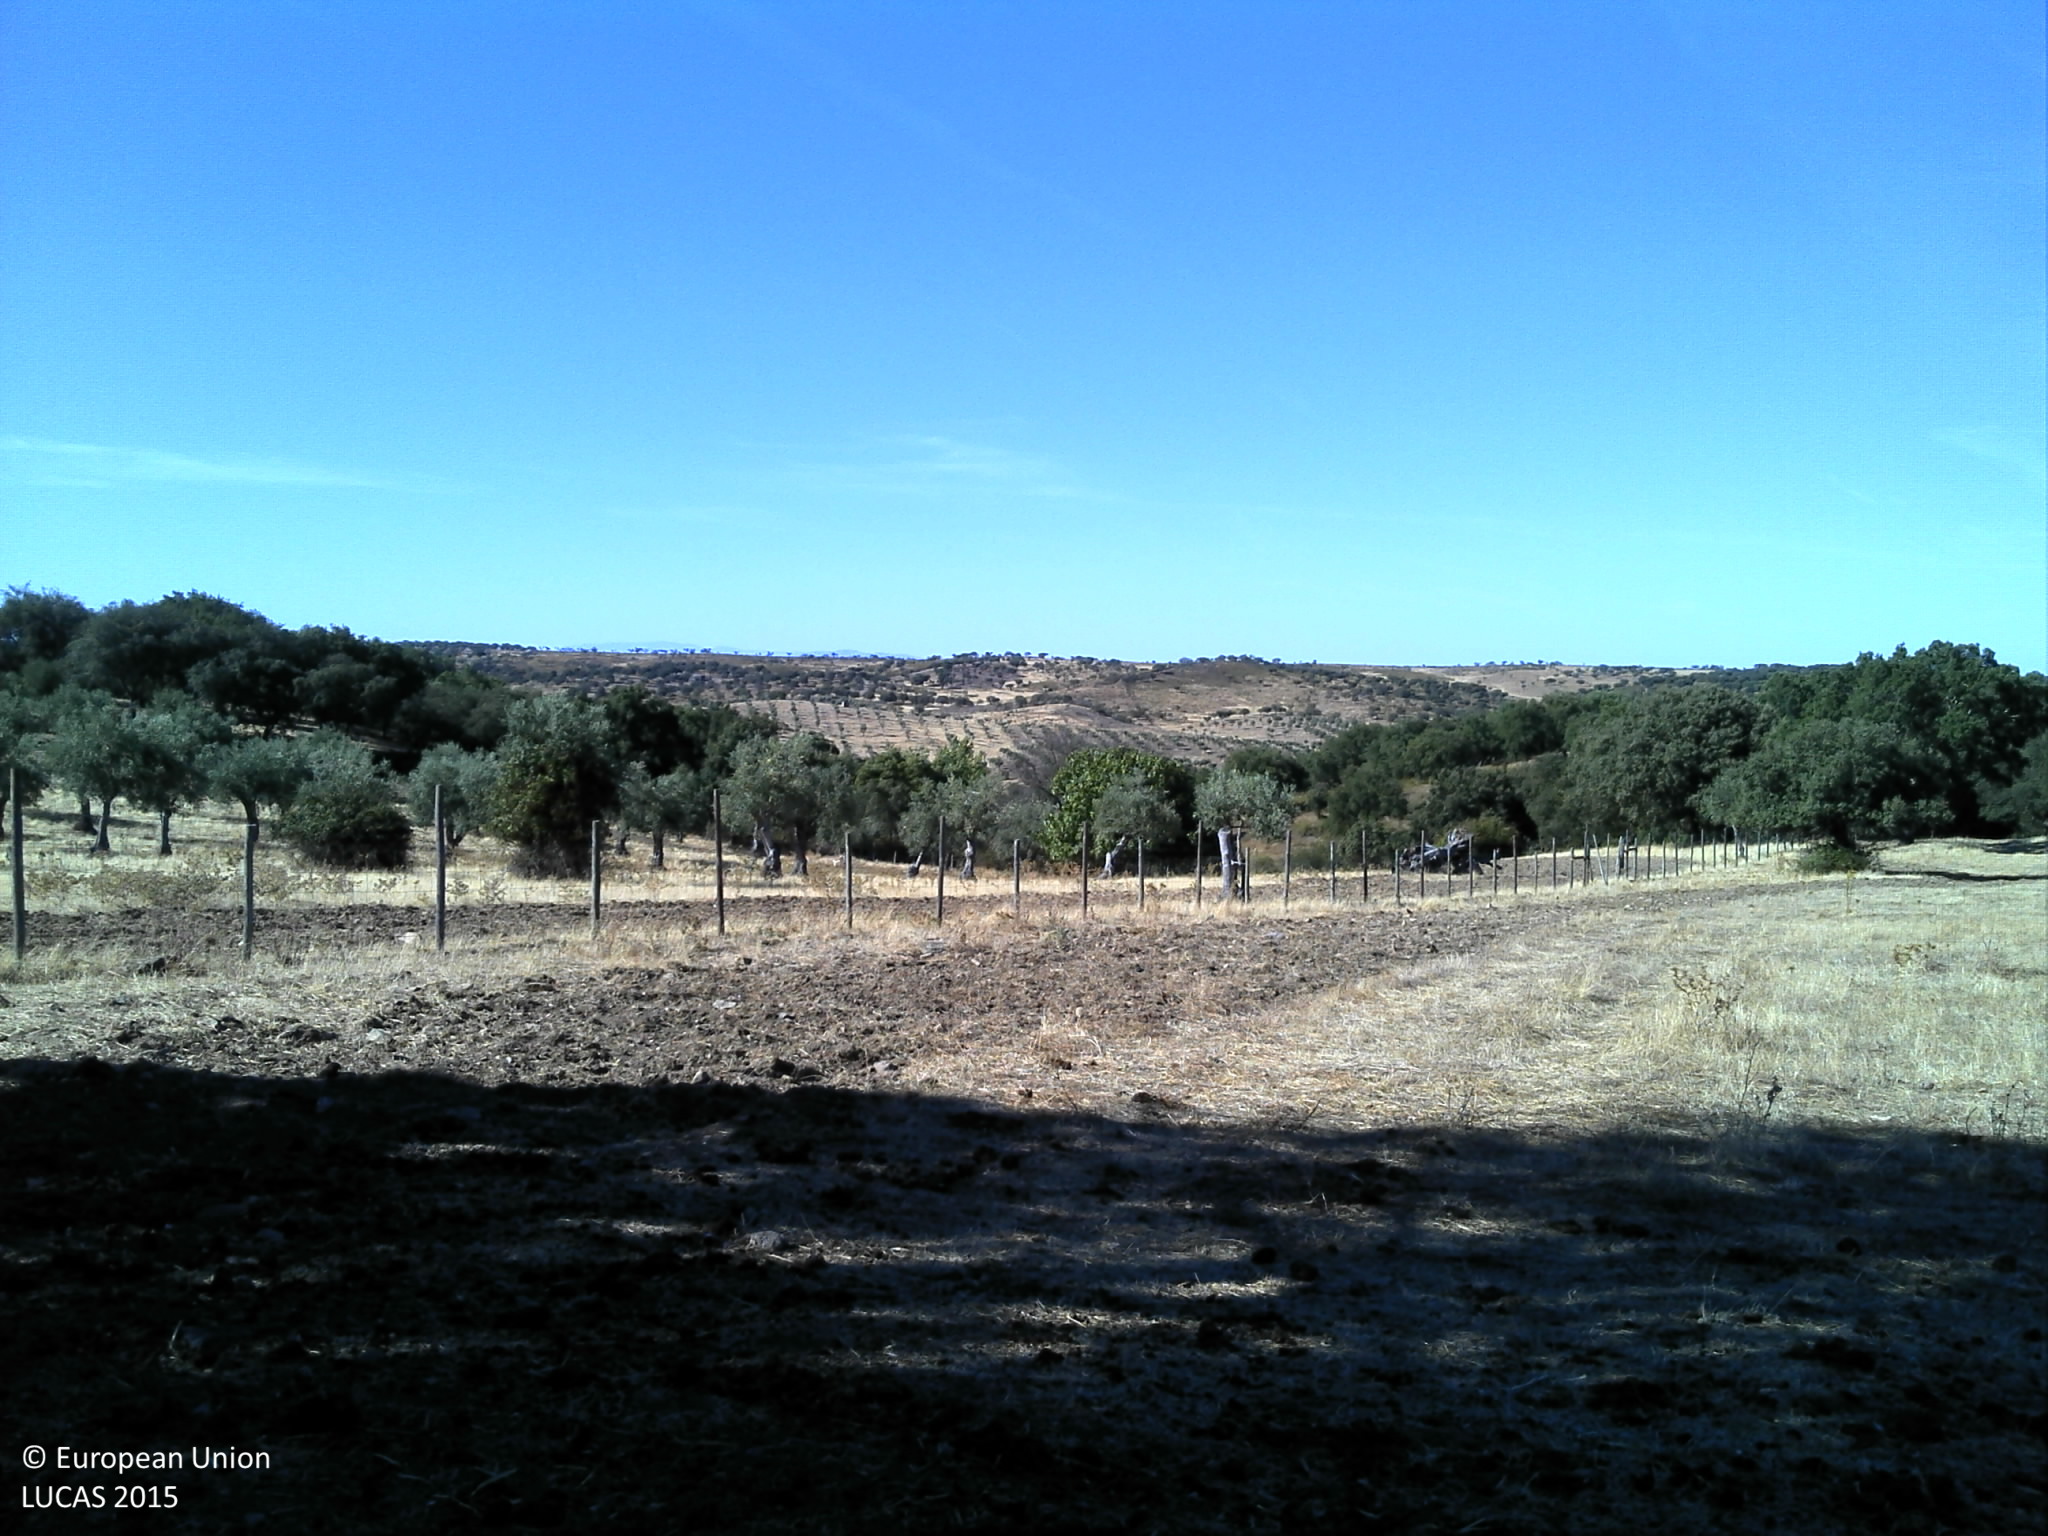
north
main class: Woodland
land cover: Broadleaved woodland
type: broadleaved evergreen forest
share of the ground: 10 - 25 %
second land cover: Grassland without tree/shrub cover
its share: 10 - 25 %
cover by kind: unconsolidated bare surface 75 %, herbaceous plants 15 %, broadleaved forest trees 10 %
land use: Forestry
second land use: Agriculture (excluding fallow land and kitchen gardens)
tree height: > 5 m
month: August
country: PT
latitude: 39.5198
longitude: -7.5550
